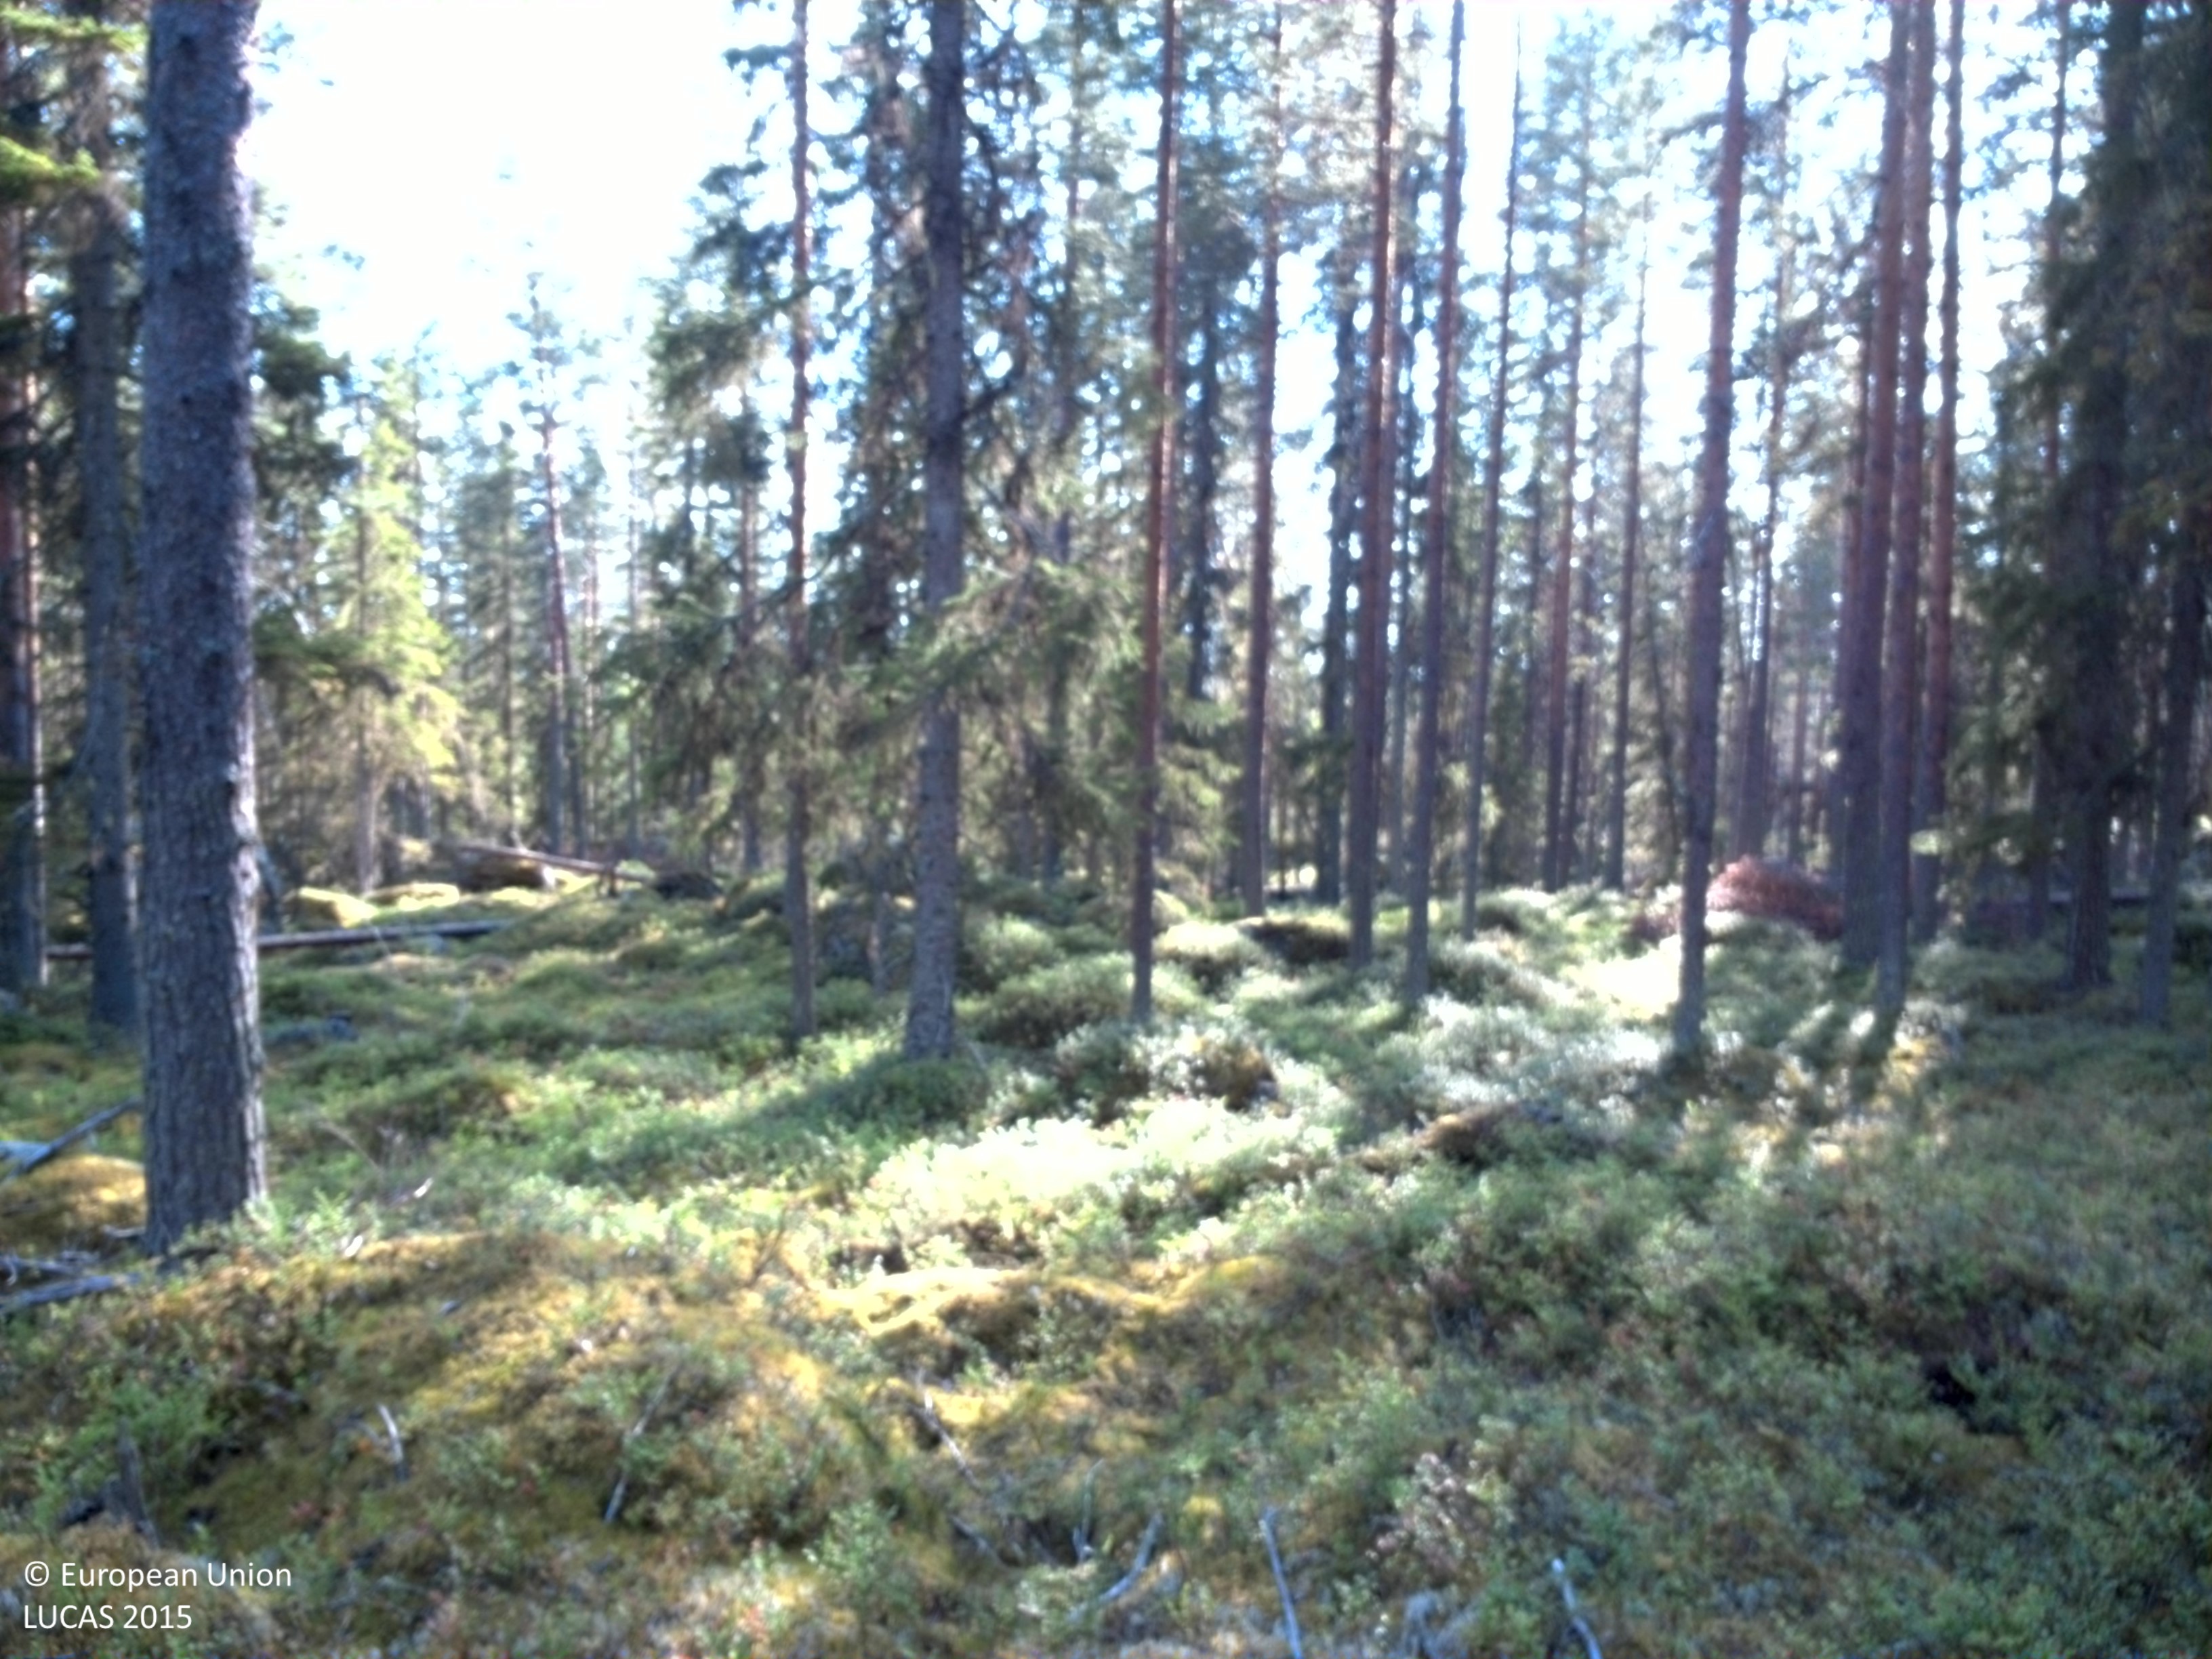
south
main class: Woodland
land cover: Pine dominated coniferous woodland
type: boreal forest
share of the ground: 50 - 75 %
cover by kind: coniferous forest trees 50 %, shrubs 45 %, lichens and mosses 5 %
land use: Forestry
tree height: > 5 m
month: August
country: SE
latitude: 64.4782
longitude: 18.8518
